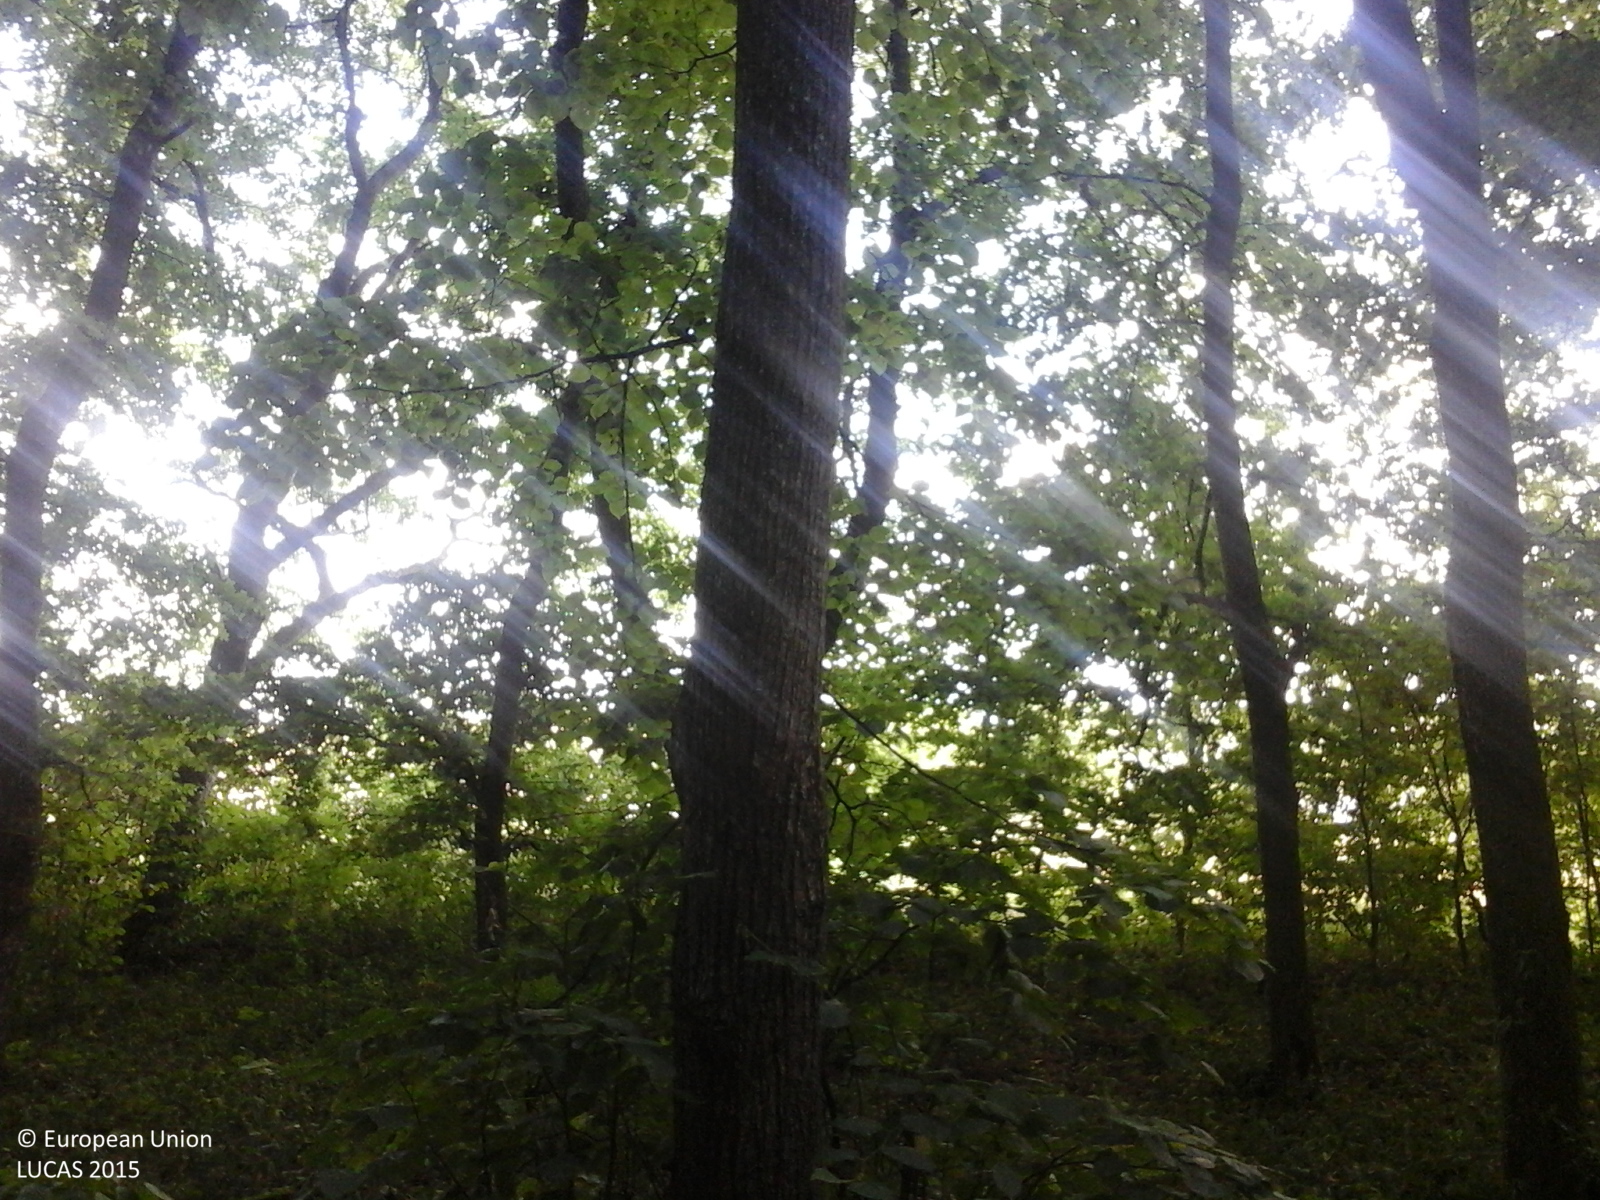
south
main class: Woodland
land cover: Broadleaved woodland
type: beech forest
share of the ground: > 75 %
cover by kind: broadleaved forest trees 90 %, herbaceous plants 10 %
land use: Forestry
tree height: > 5 m
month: June
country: RO
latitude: 47.7104
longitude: 26.3330
